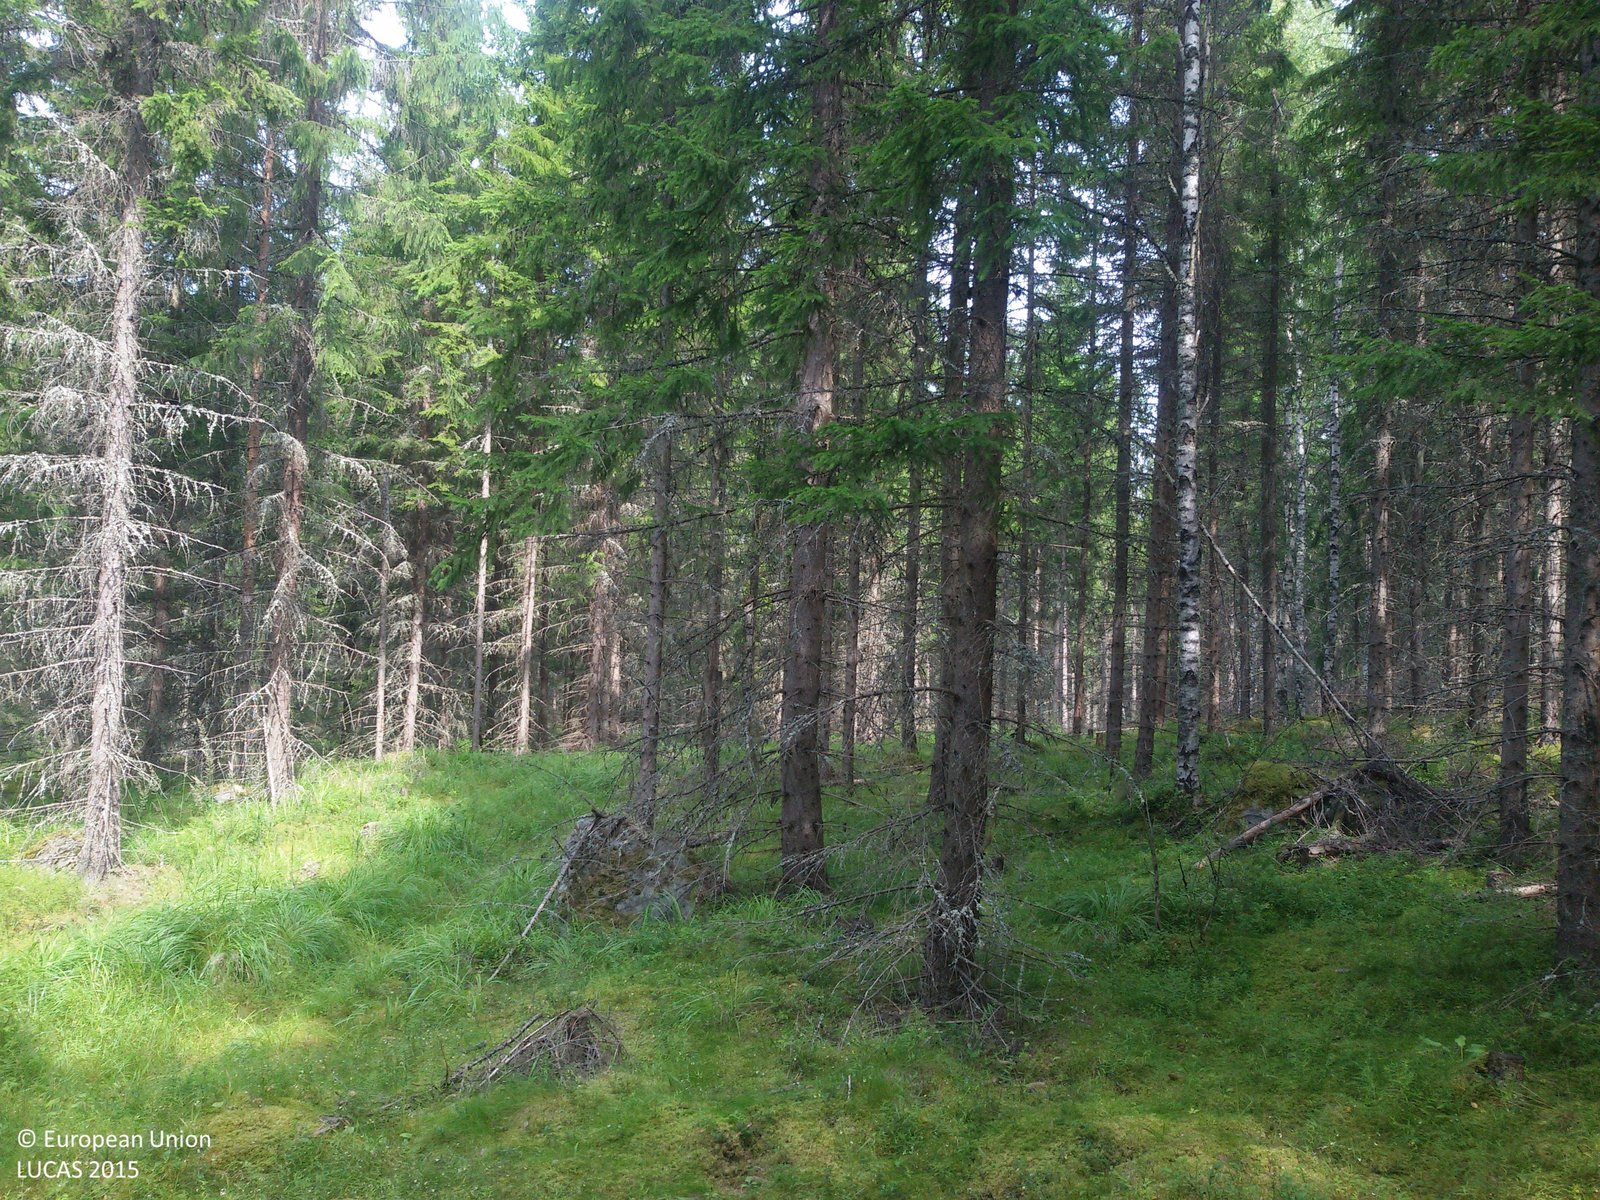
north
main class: Woodland
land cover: Spruce dominated coniferous woodland
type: boreal forest
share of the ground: > 75 %
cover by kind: coniferous forest trees 80 %, herbaceous plants 15 %, shrubs 5 %
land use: Forestry
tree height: > 5 m
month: August
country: SE
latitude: 60.4571
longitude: 16.6616
